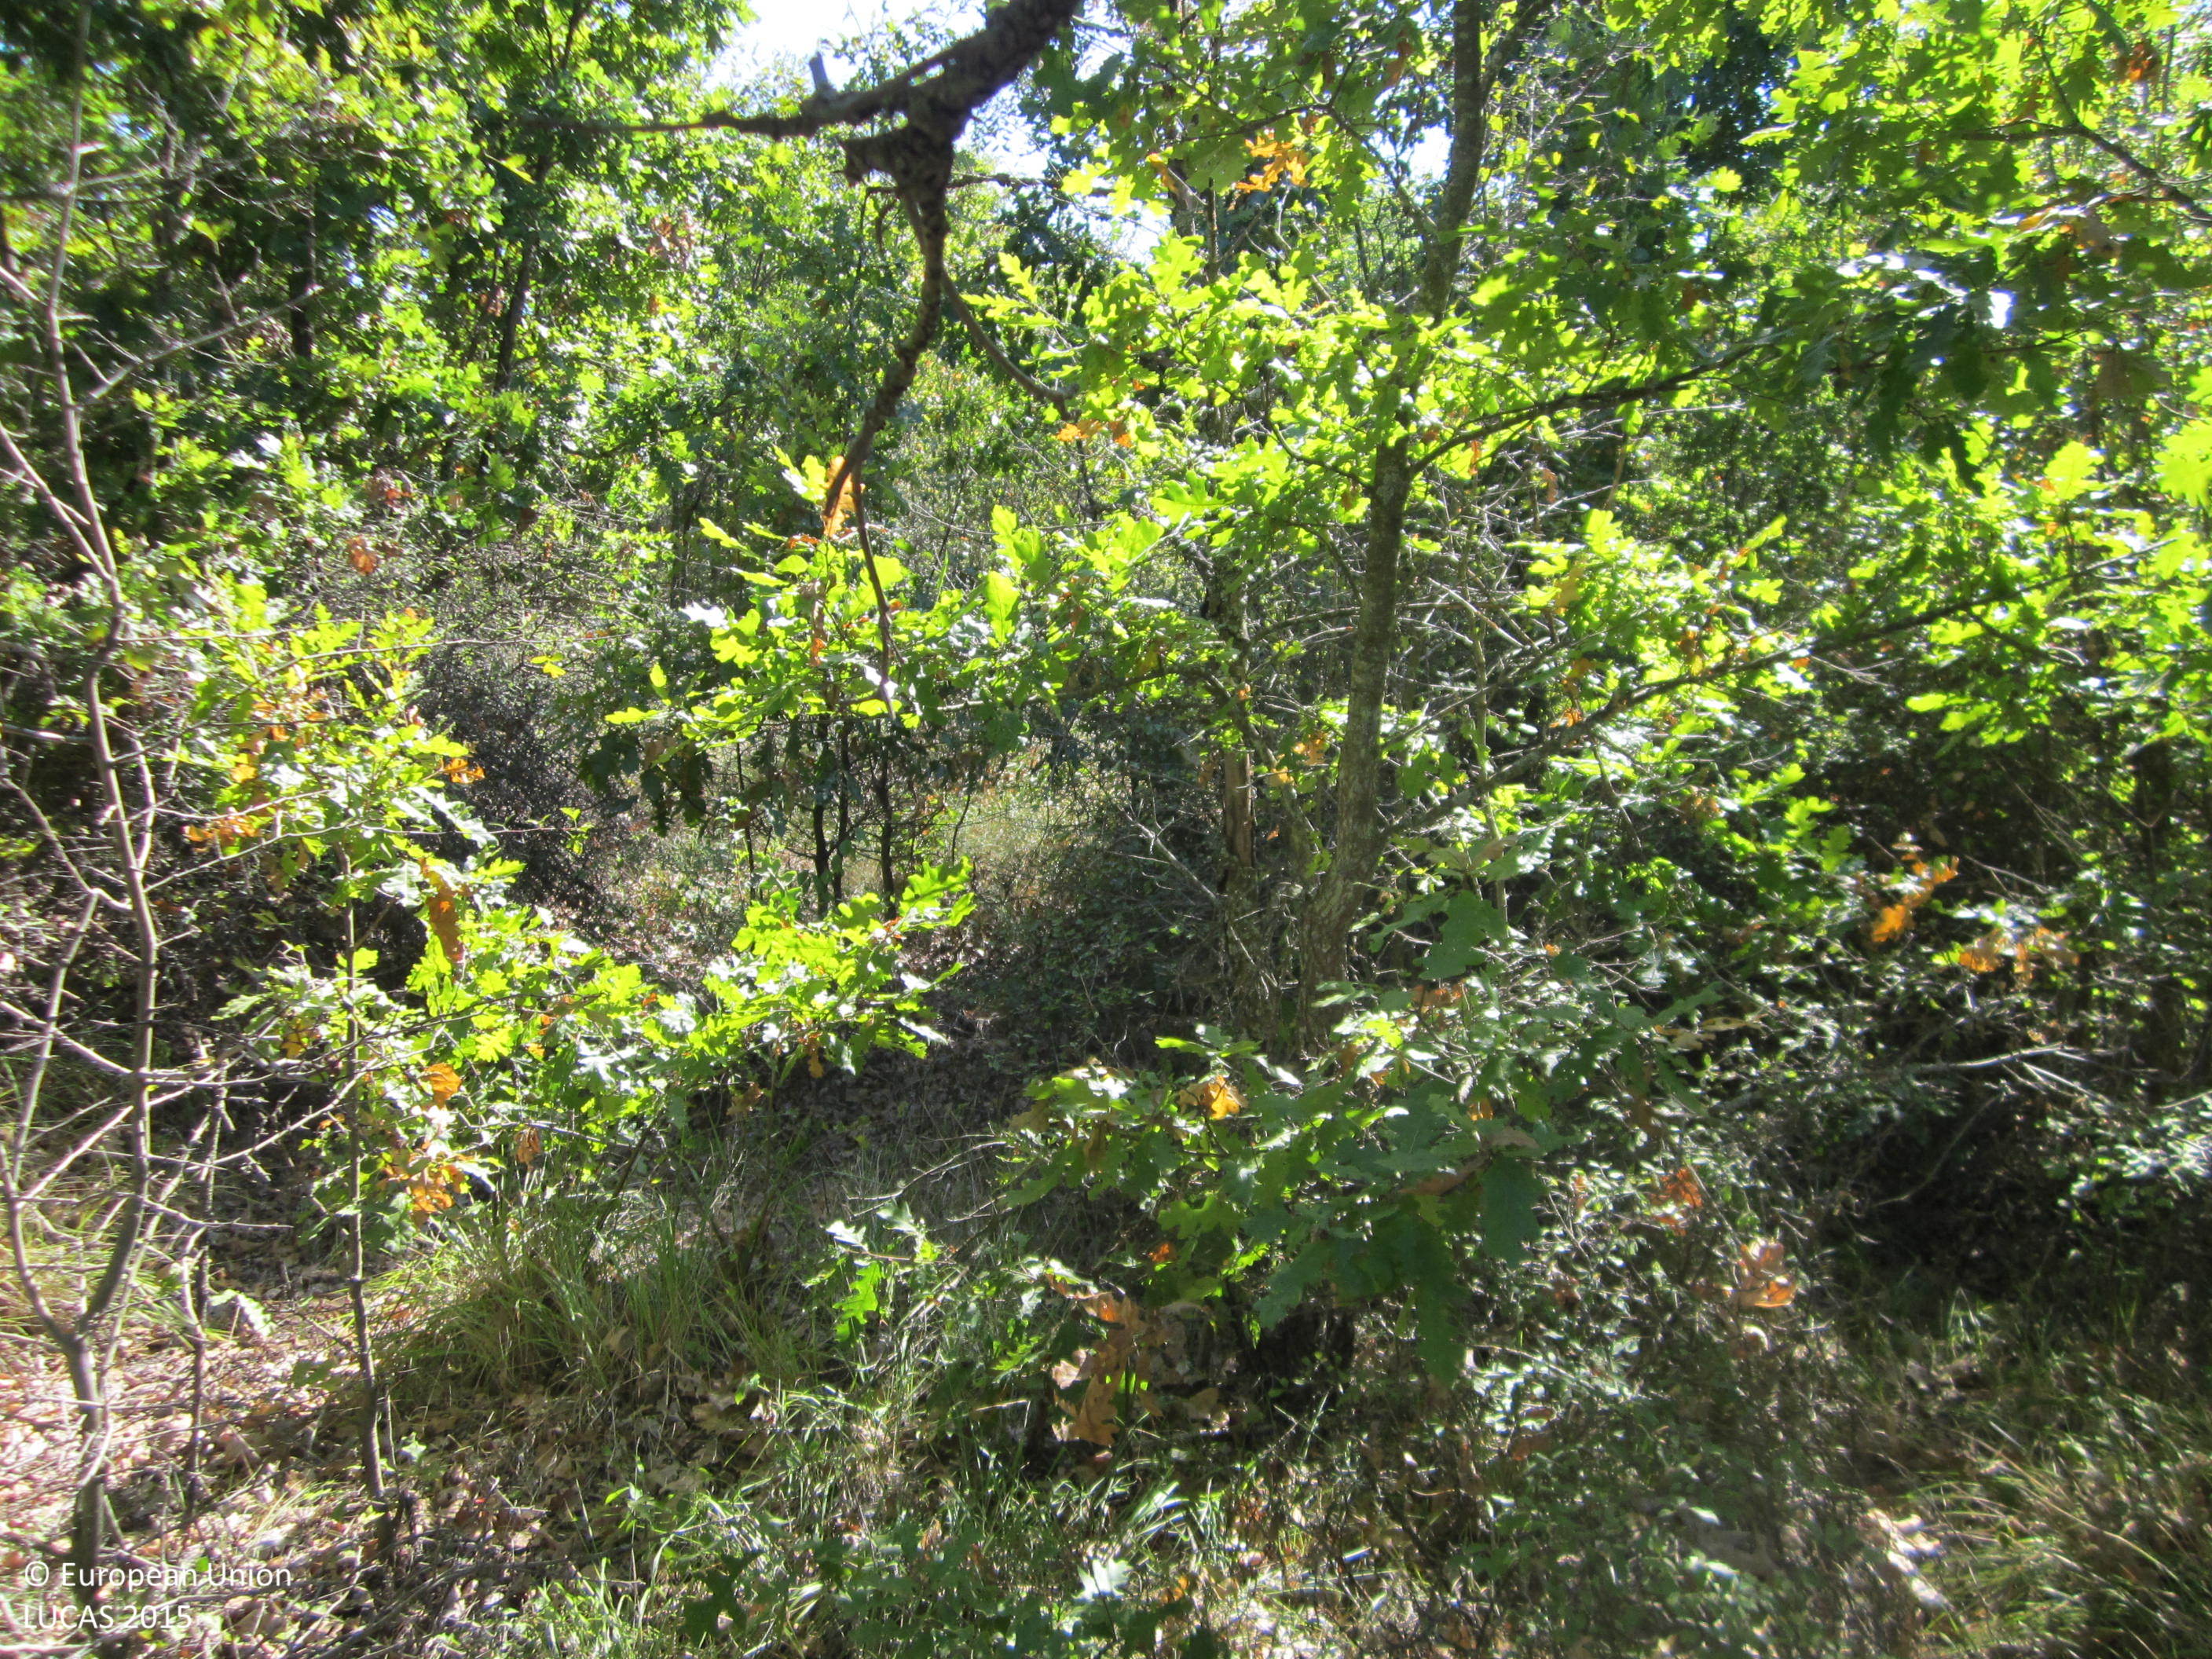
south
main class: Woodland
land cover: Broadleaved woodland
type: thermophilous deciduous forest
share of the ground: > 75 %
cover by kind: broadleaved forest trees 90 %, shrubs 5 %, herbaceous plants 5 %
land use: Forestry
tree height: > 5 m
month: September
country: BG
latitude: 42.2700
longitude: 27.0151
